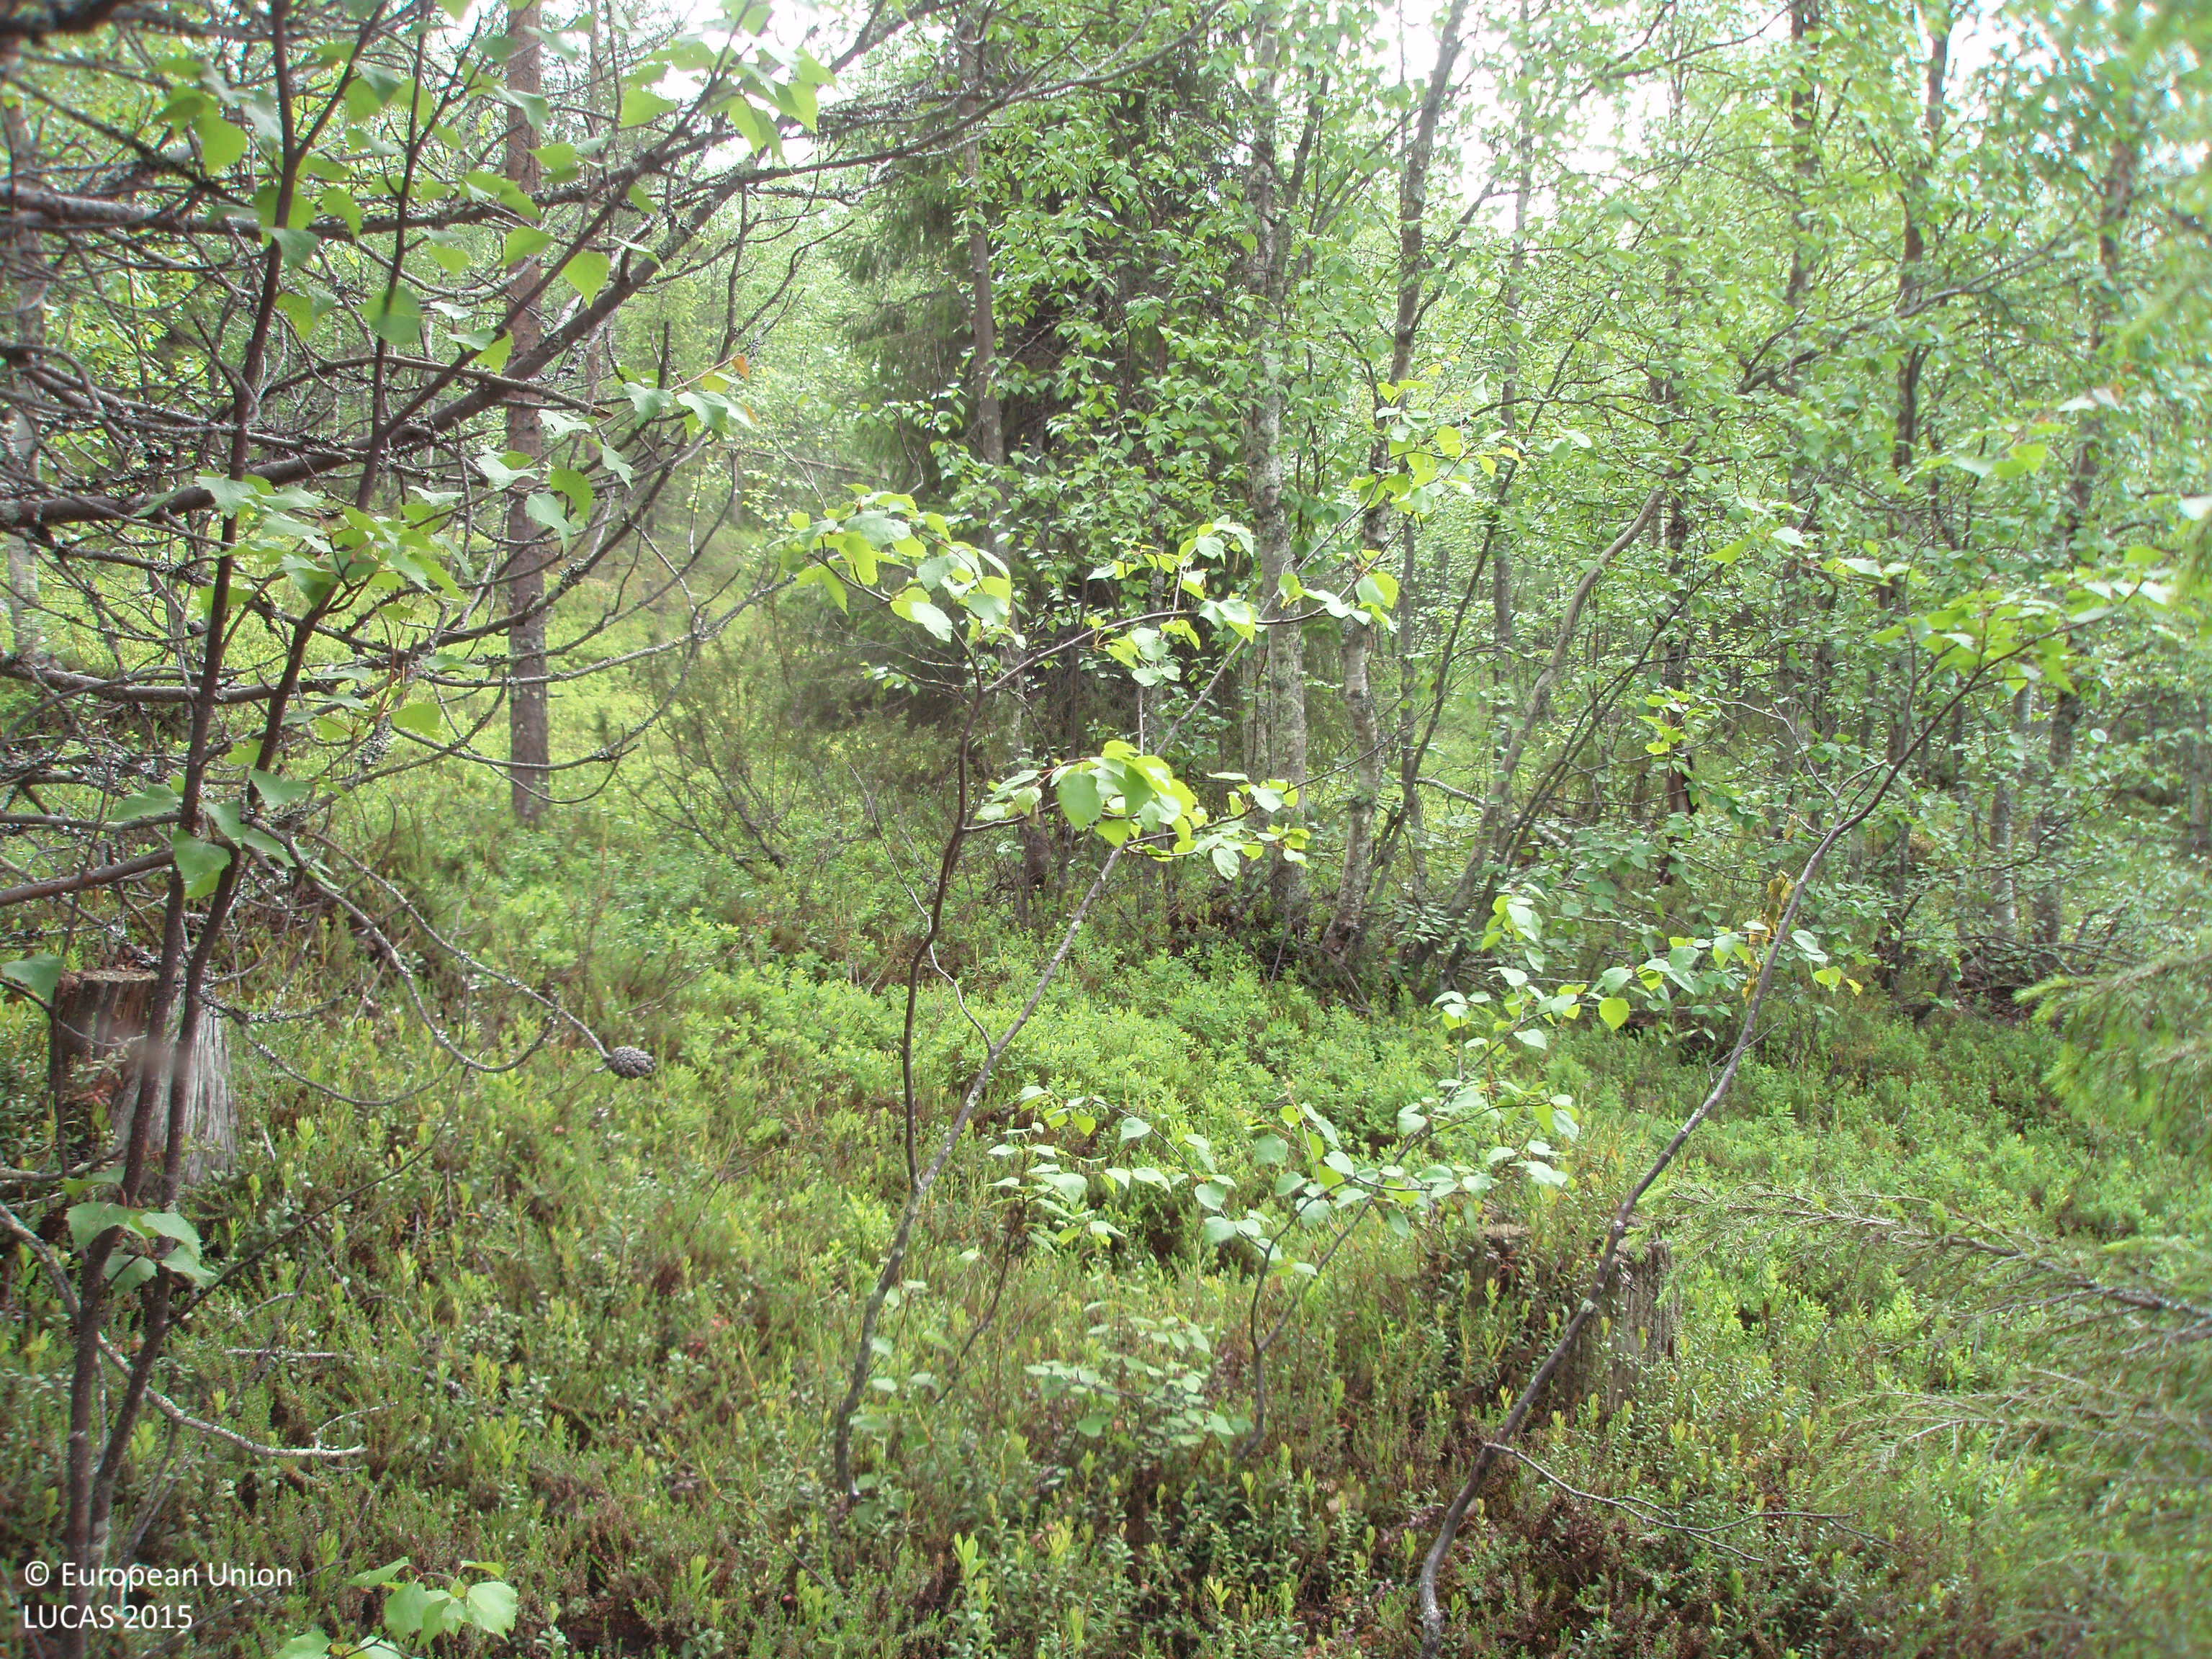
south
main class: Woodland
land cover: Other mixed woodland
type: boreal forest
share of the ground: > 75 %
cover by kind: coniferous forest trees 45 %, broadleaved forest trees 35 %, shrubs 20 %
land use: Forestry
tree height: > 5 m
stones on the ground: > 50 %
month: July
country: FI
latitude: 67.4242
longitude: 27.4884
